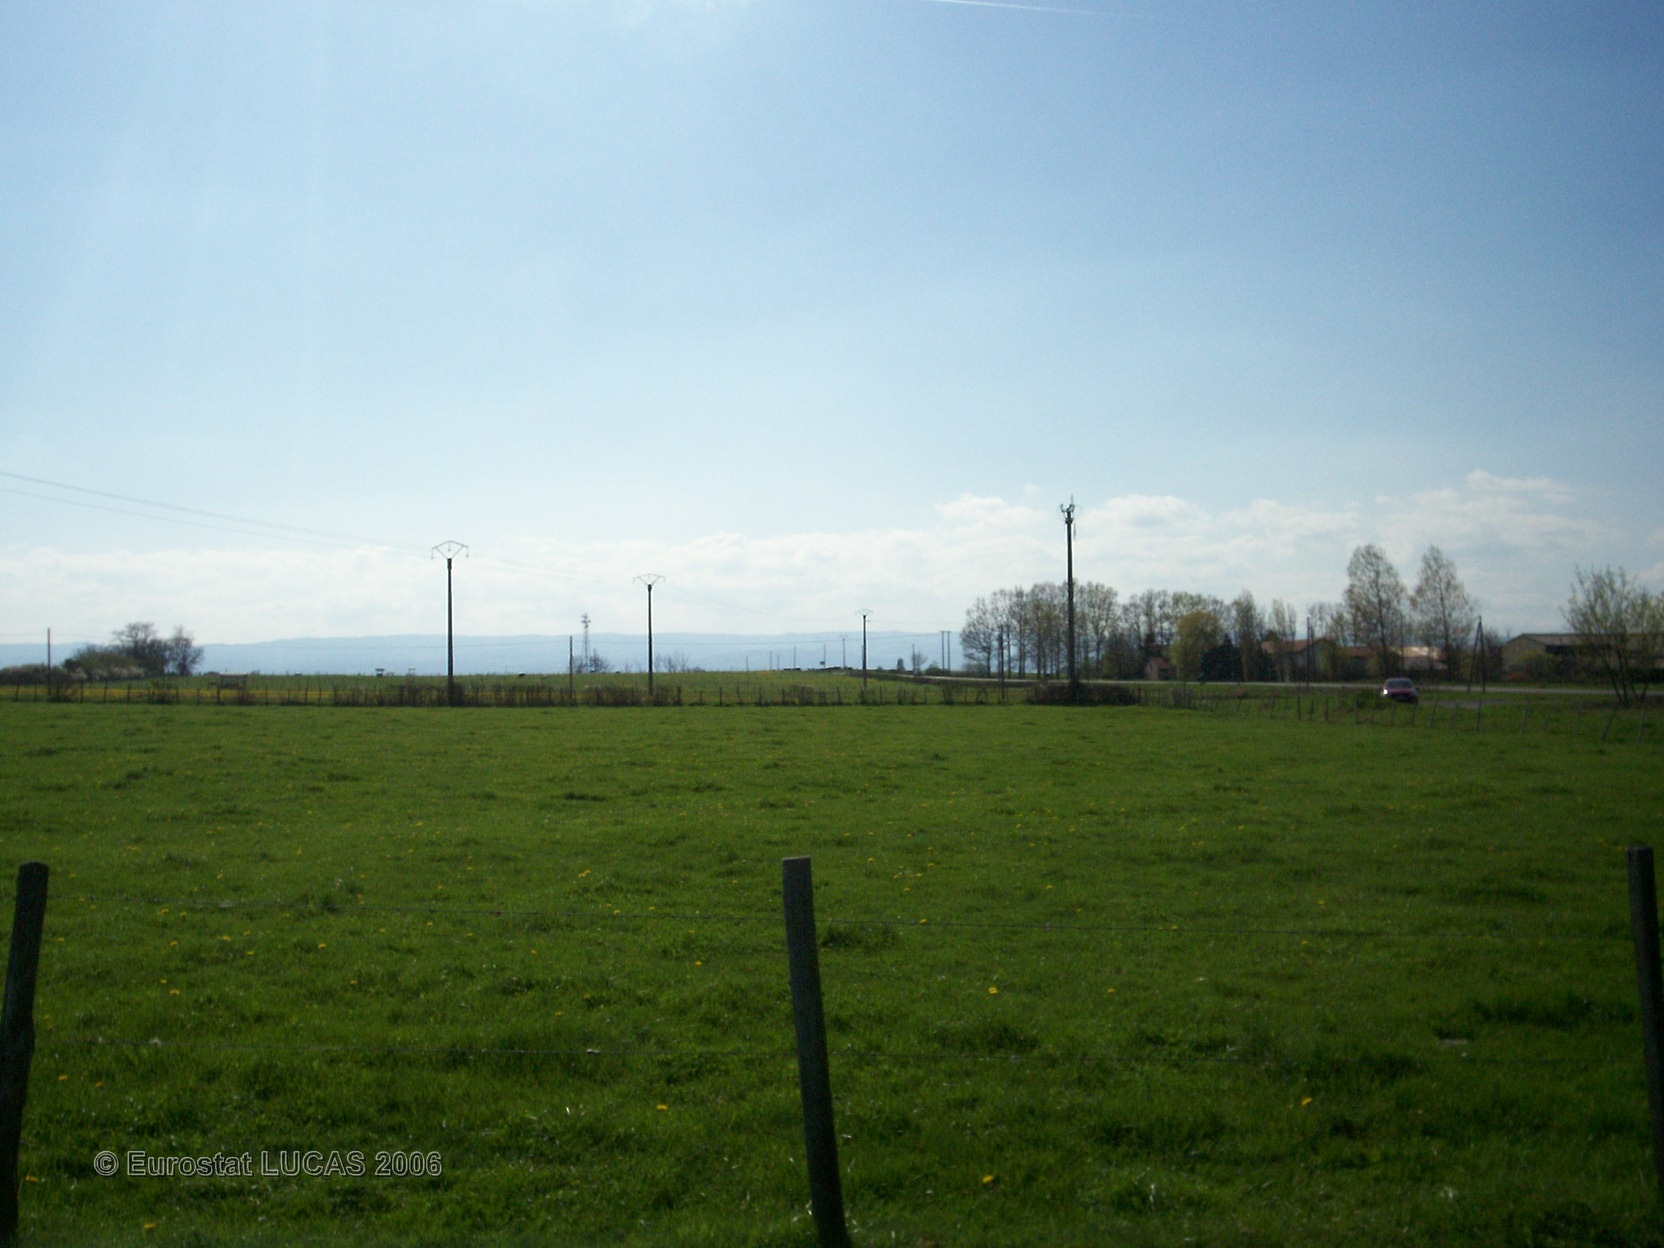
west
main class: Grassland
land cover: Grassland without tree/shrub cover
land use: Agriculture (excluding fallow land and kitchen gardens)
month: April
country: FR
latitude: 45.6335
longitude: 4.1919
